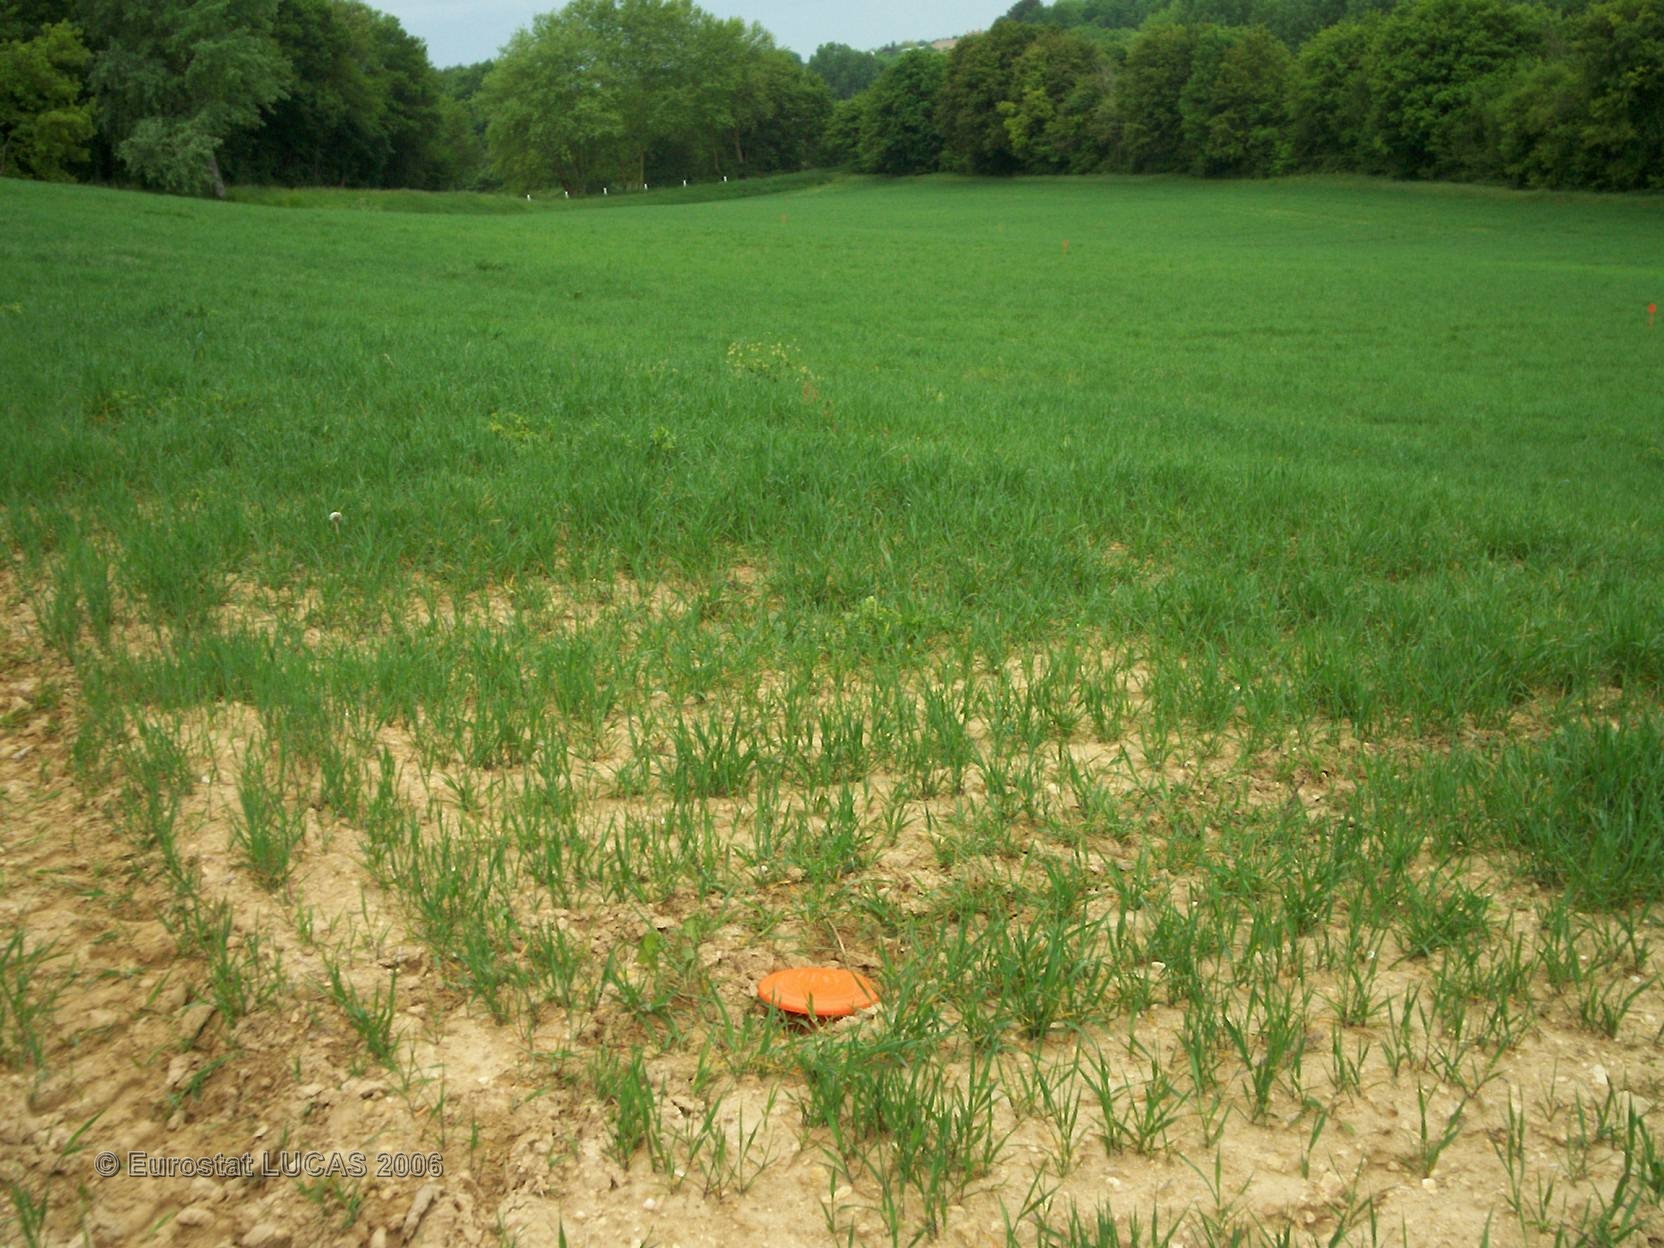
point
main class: Cropland
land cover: Barley
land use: Agriculture (excluding fallow land and kitchen gardens)
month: May
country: FR
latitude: 46.9124
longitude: 0.9908
